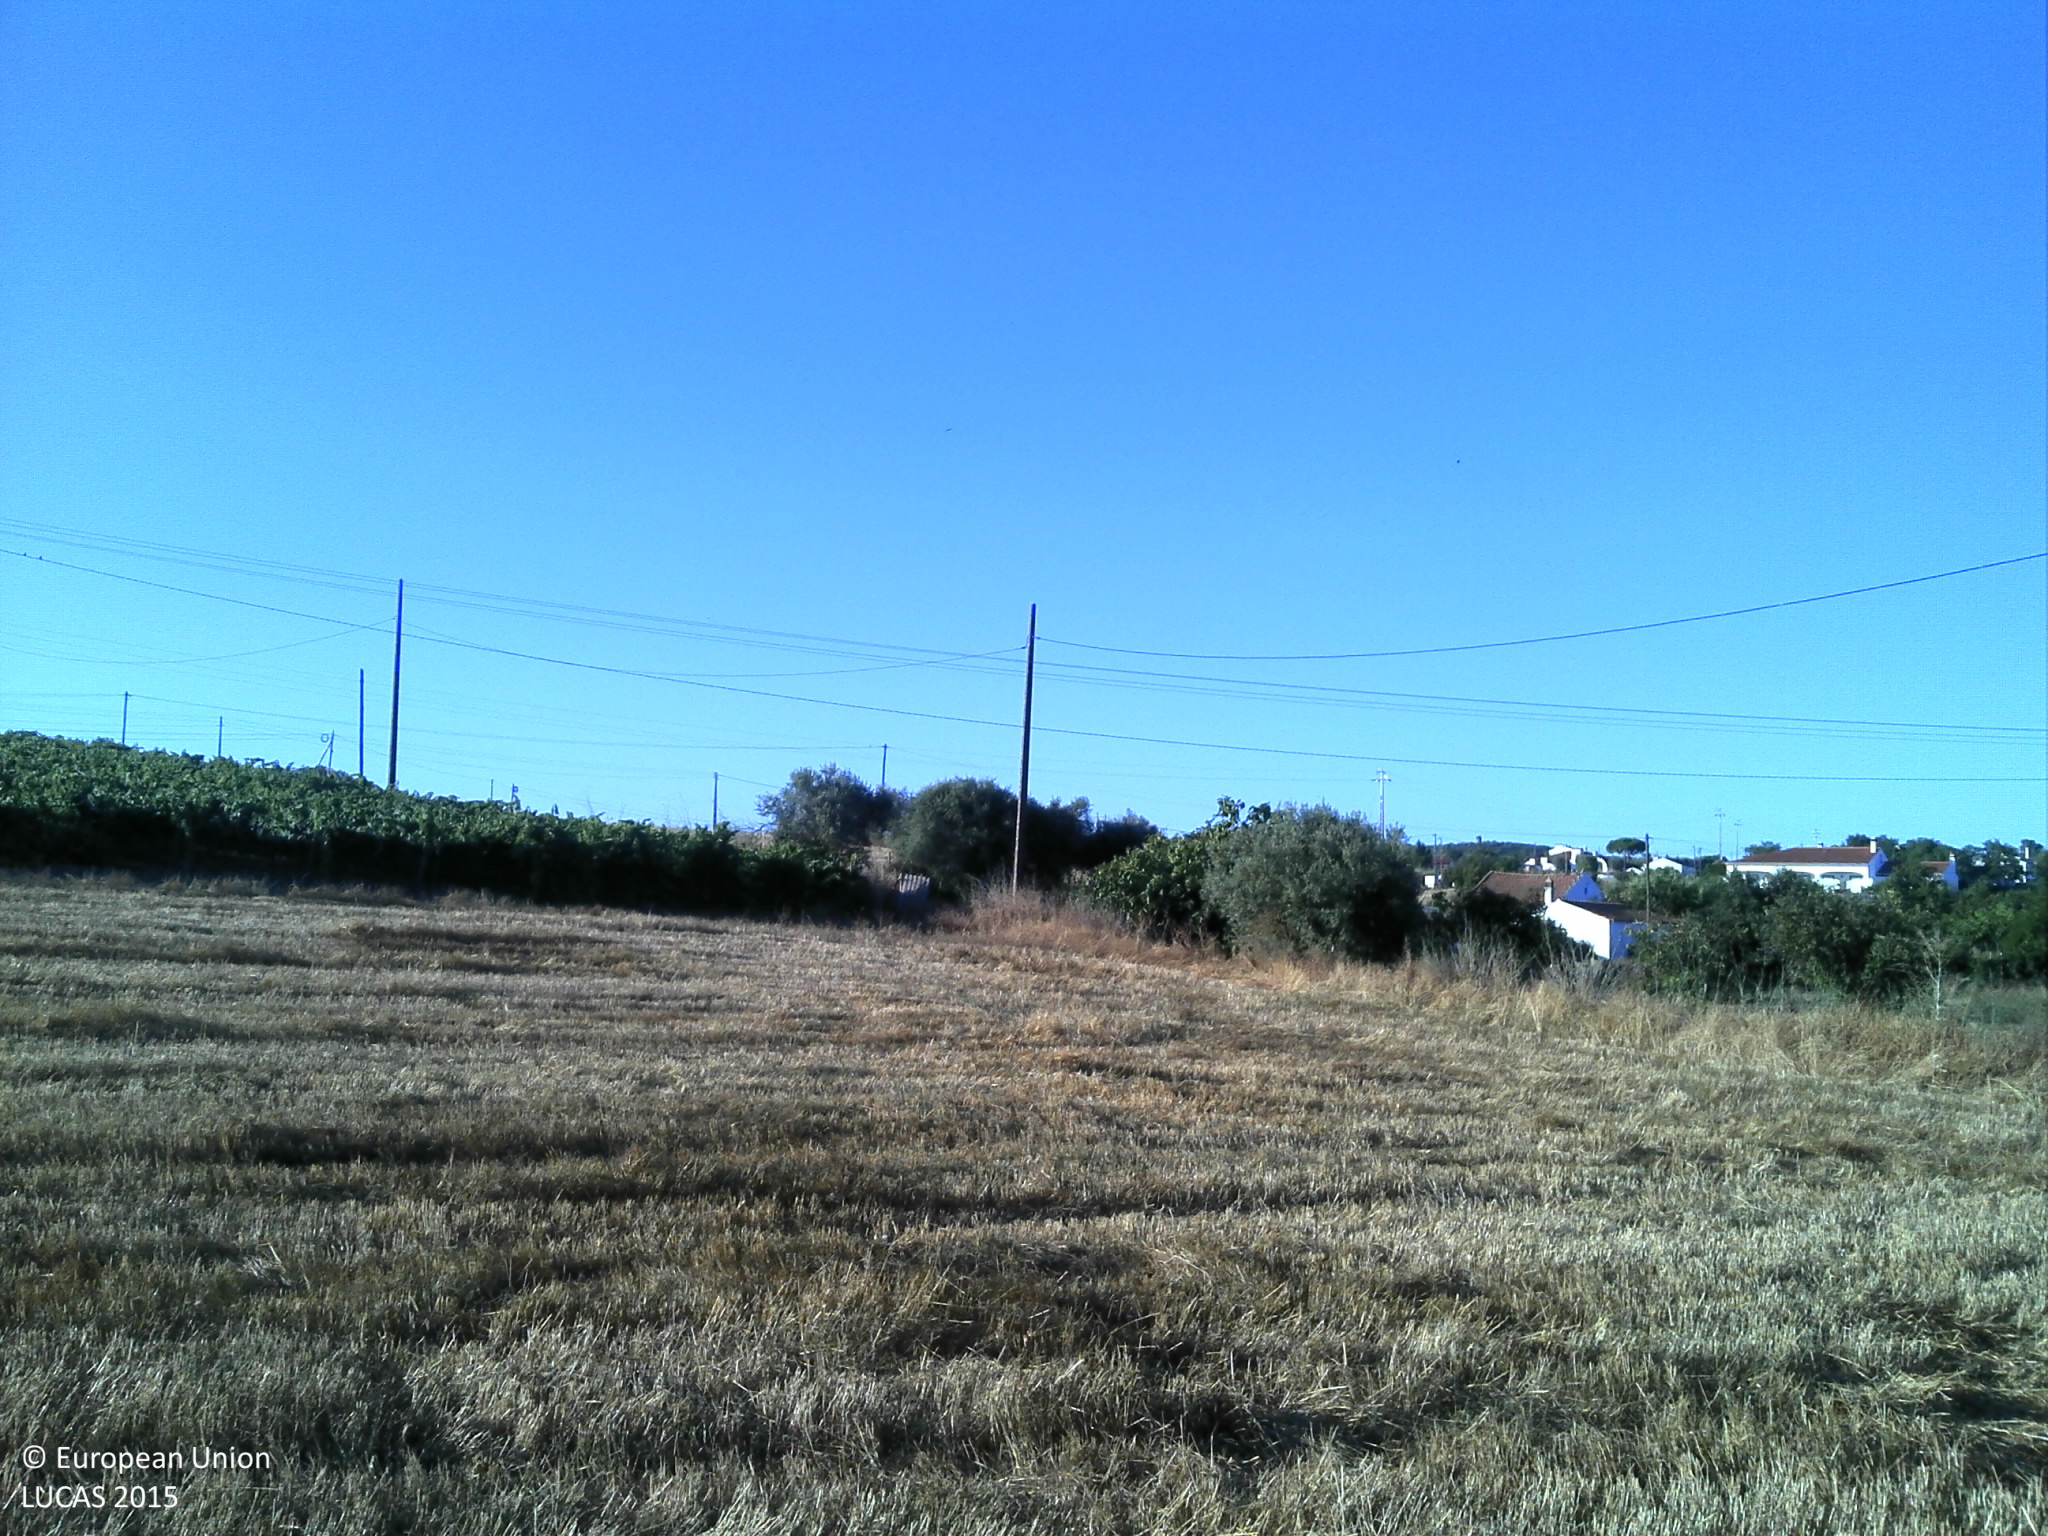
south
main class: Cropland
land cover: Triticale
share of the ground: < 10 %
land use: Agriculture (excluding fallow land and kitchen gardens)
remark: Harvested field
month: July
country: PT
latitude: 38.8712
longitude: -7.5678
